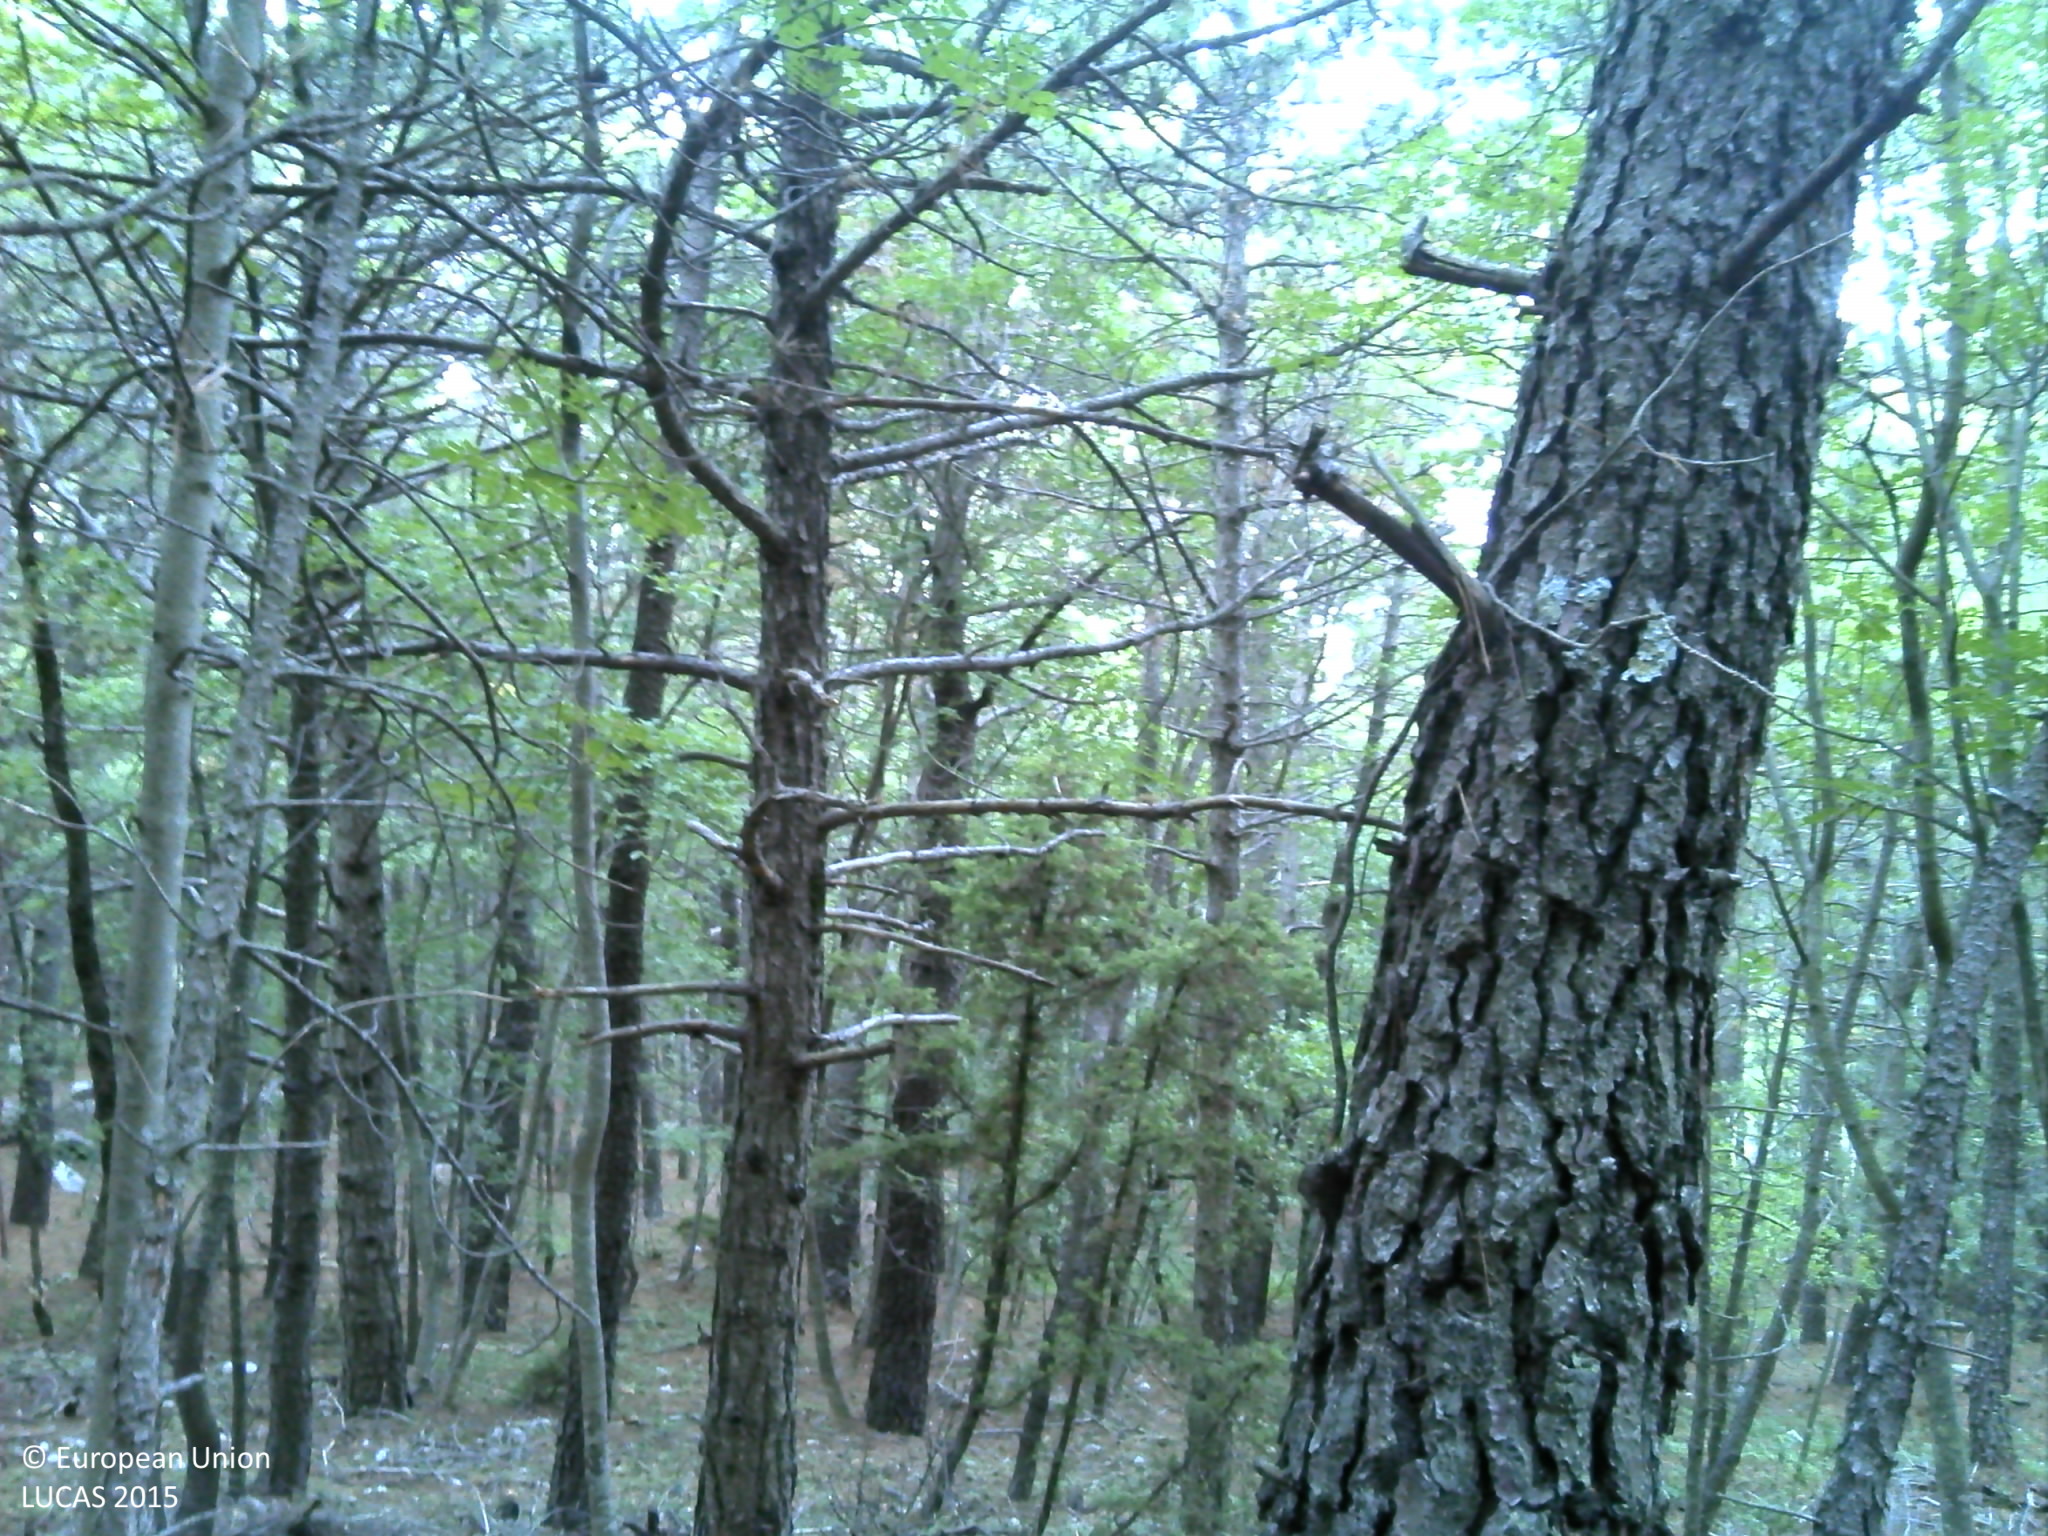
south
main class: Woodland
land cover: Pine dominated coniferous woodland
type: coniferous forest of the mediterranean region
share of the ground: > 75 %
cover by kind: coniferous forest trees 80 %, broadleaved forest trees 5 %, shrubs 5 %, consolidated bare surface 5 %, unconsolidated bare surface 5 %
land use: Semi-natural and natural areas not in use
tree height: > 5 m
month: August
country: HR
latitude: 43.2563
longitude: 17.0983
